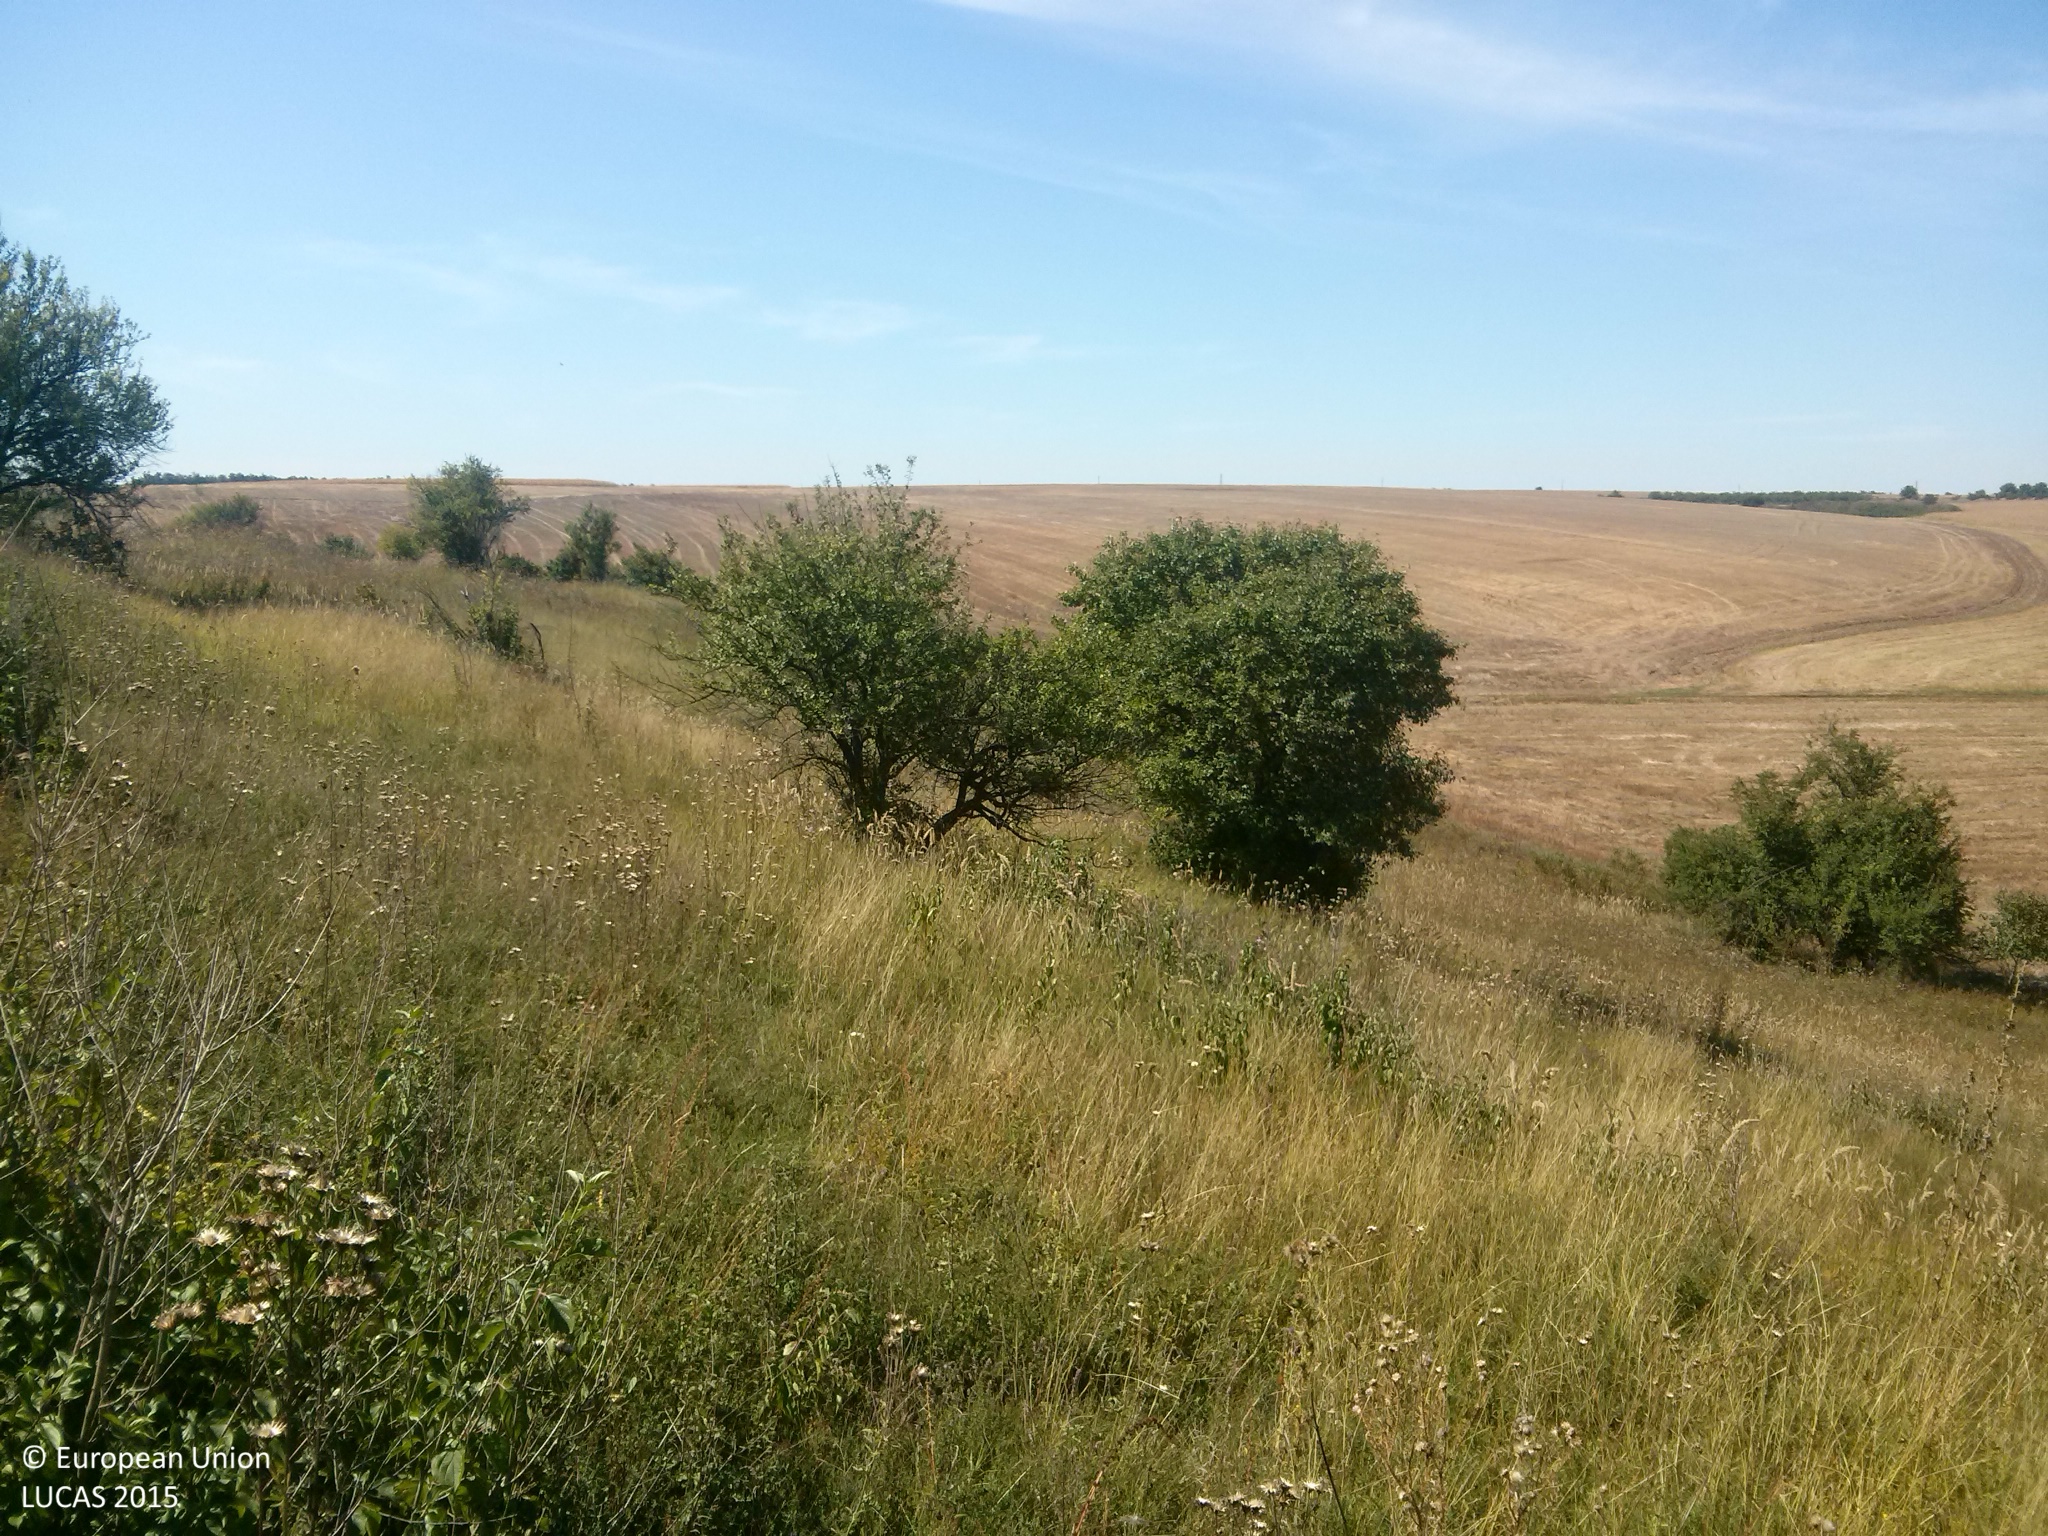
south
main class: Grassland
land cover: Grassland with sparse tree/shrub cover
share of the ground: > 75 %
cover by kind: herbaceous plants 95 %, broadleaved forest trees 5 %
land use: Agriculture (excluding fallow land and kitchen gardens)
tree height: < 5 m
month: September
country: BG
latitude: 43.7147
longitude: 26.4010
